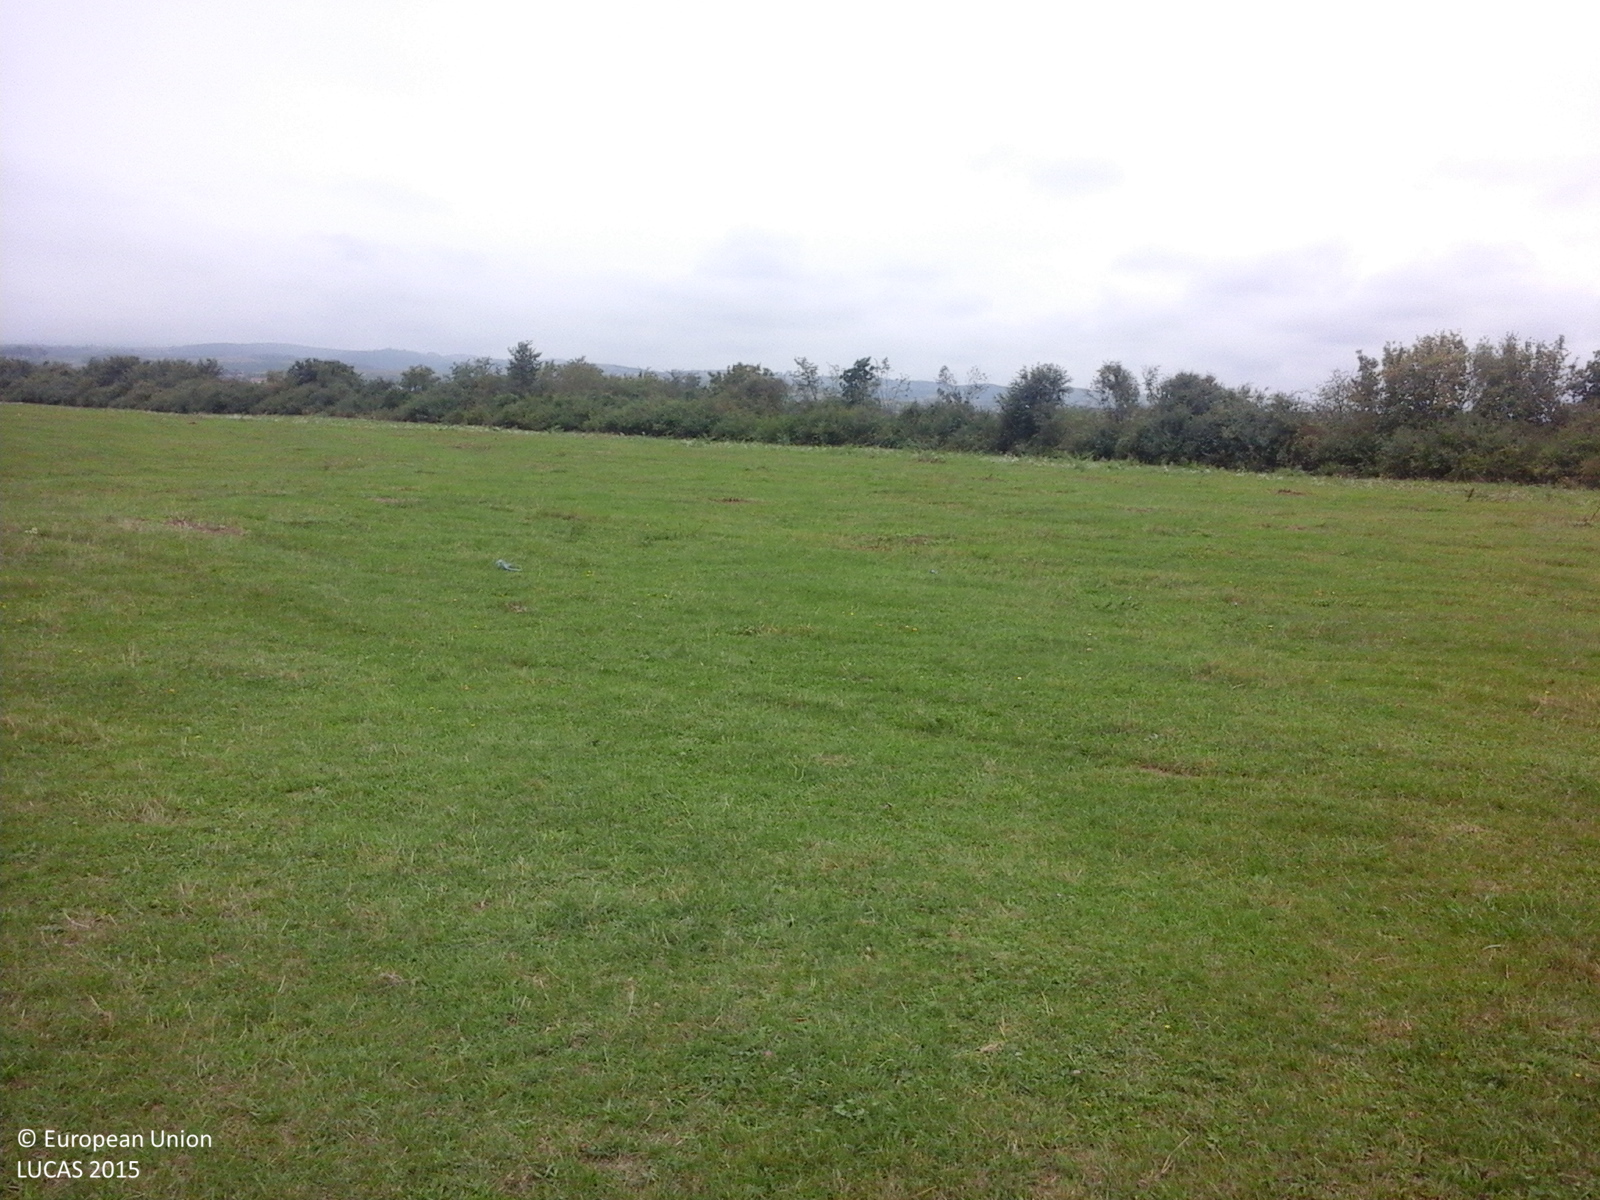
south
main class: Grassland
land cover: Grassland without tree/shrub cover
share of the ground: > 75 %
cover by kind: herbaceous plants 100 %
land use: Agriculture (excluding fallow land and kitchen gardens)
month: September
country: RO
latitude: 47.0427
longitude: 22.2784
